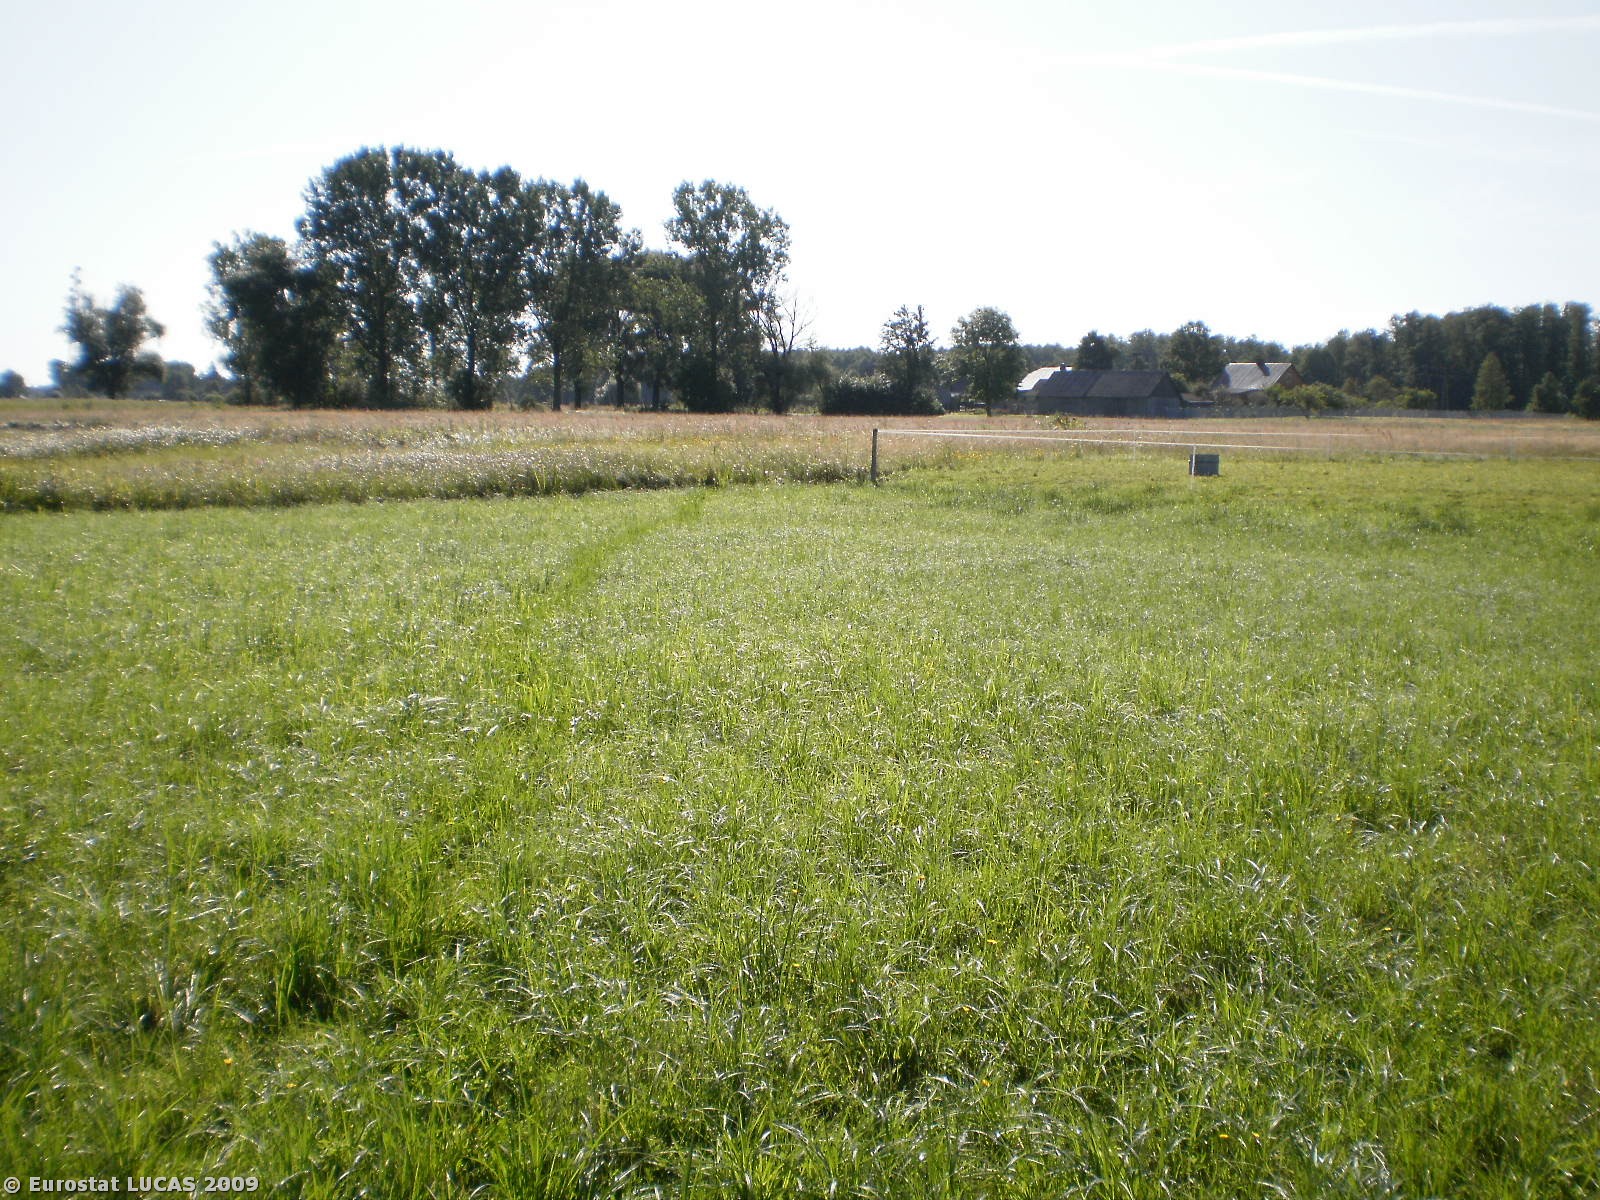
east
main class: Grassland
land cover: Grassland without tree/shrub cover
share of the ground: > 75 %
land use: Agriculture (excluding fallow land and kitchen gardens)
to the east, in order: Grassland without tree/shrub cover
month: August
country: PL
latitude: 52.6137
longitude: 21.7065
